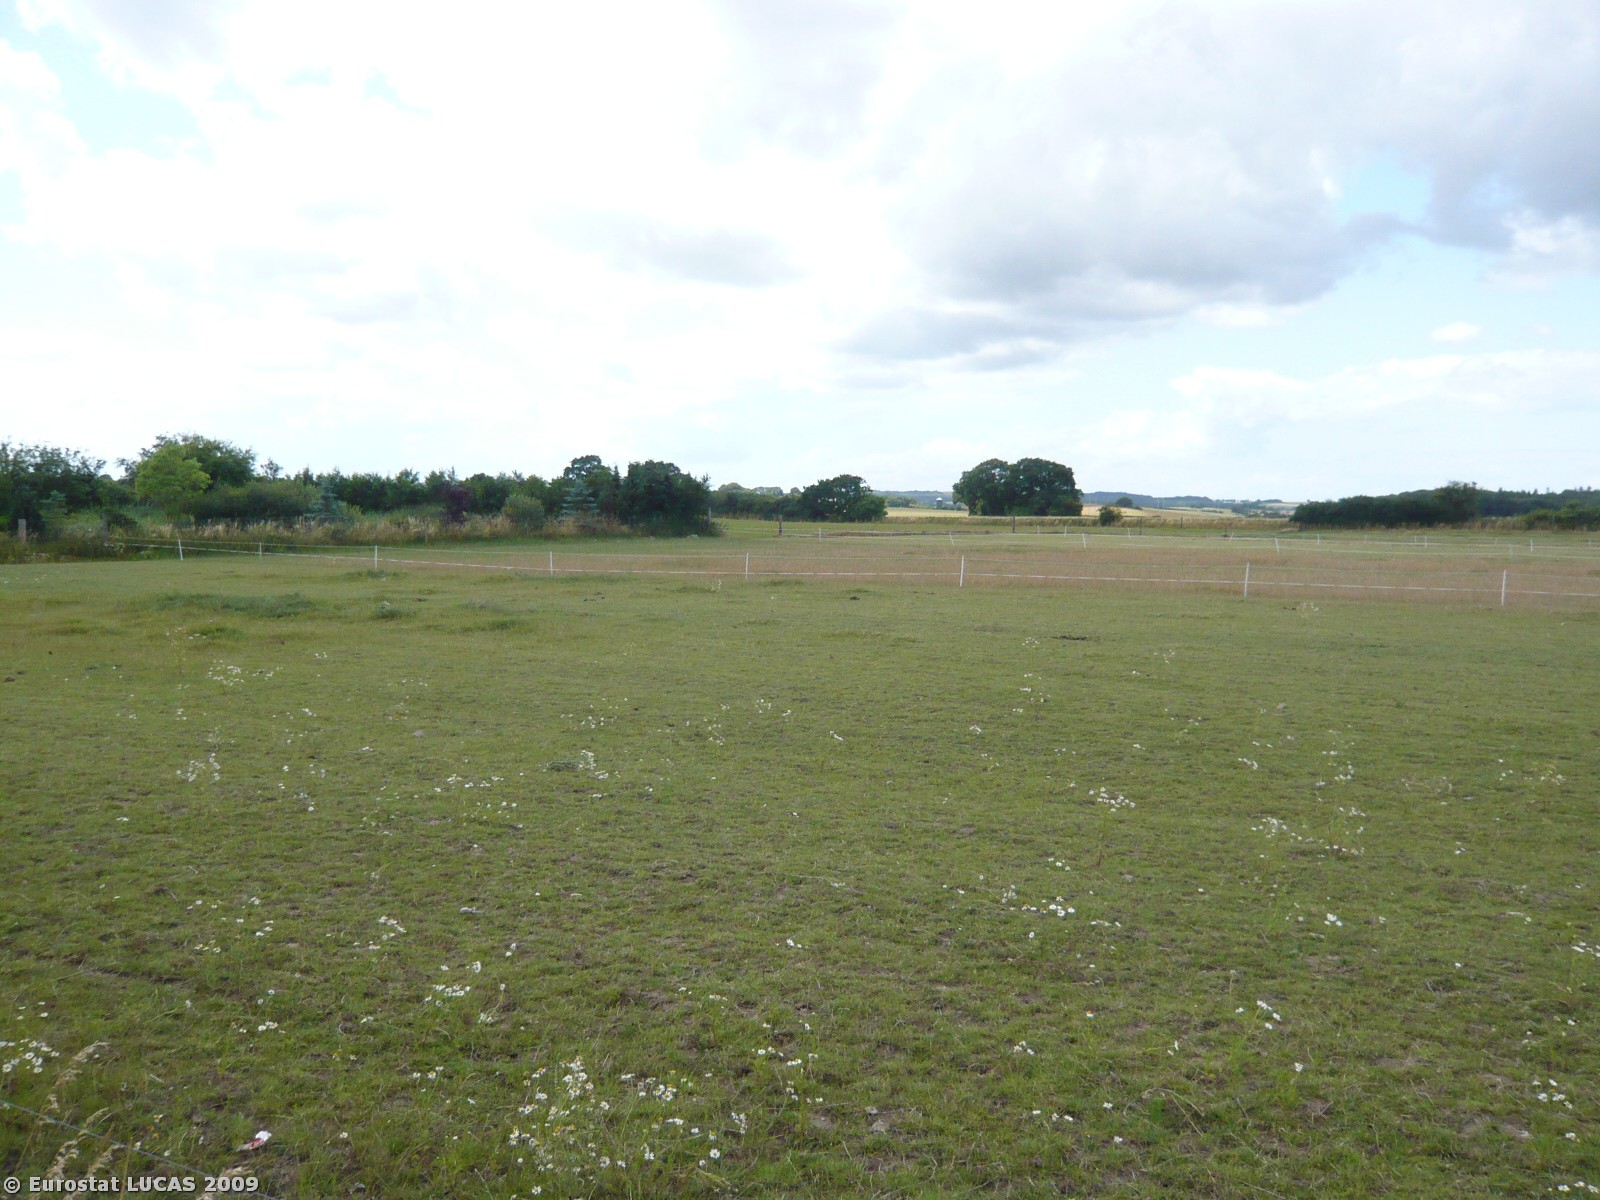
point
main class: Grassland
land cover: Grassland without tree/shrub cover
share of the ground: > 75 %
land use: Agriculture (excluding fallow land and kitchen gardens)
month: July
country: DK
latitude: 55.5684
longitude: 11.4418
